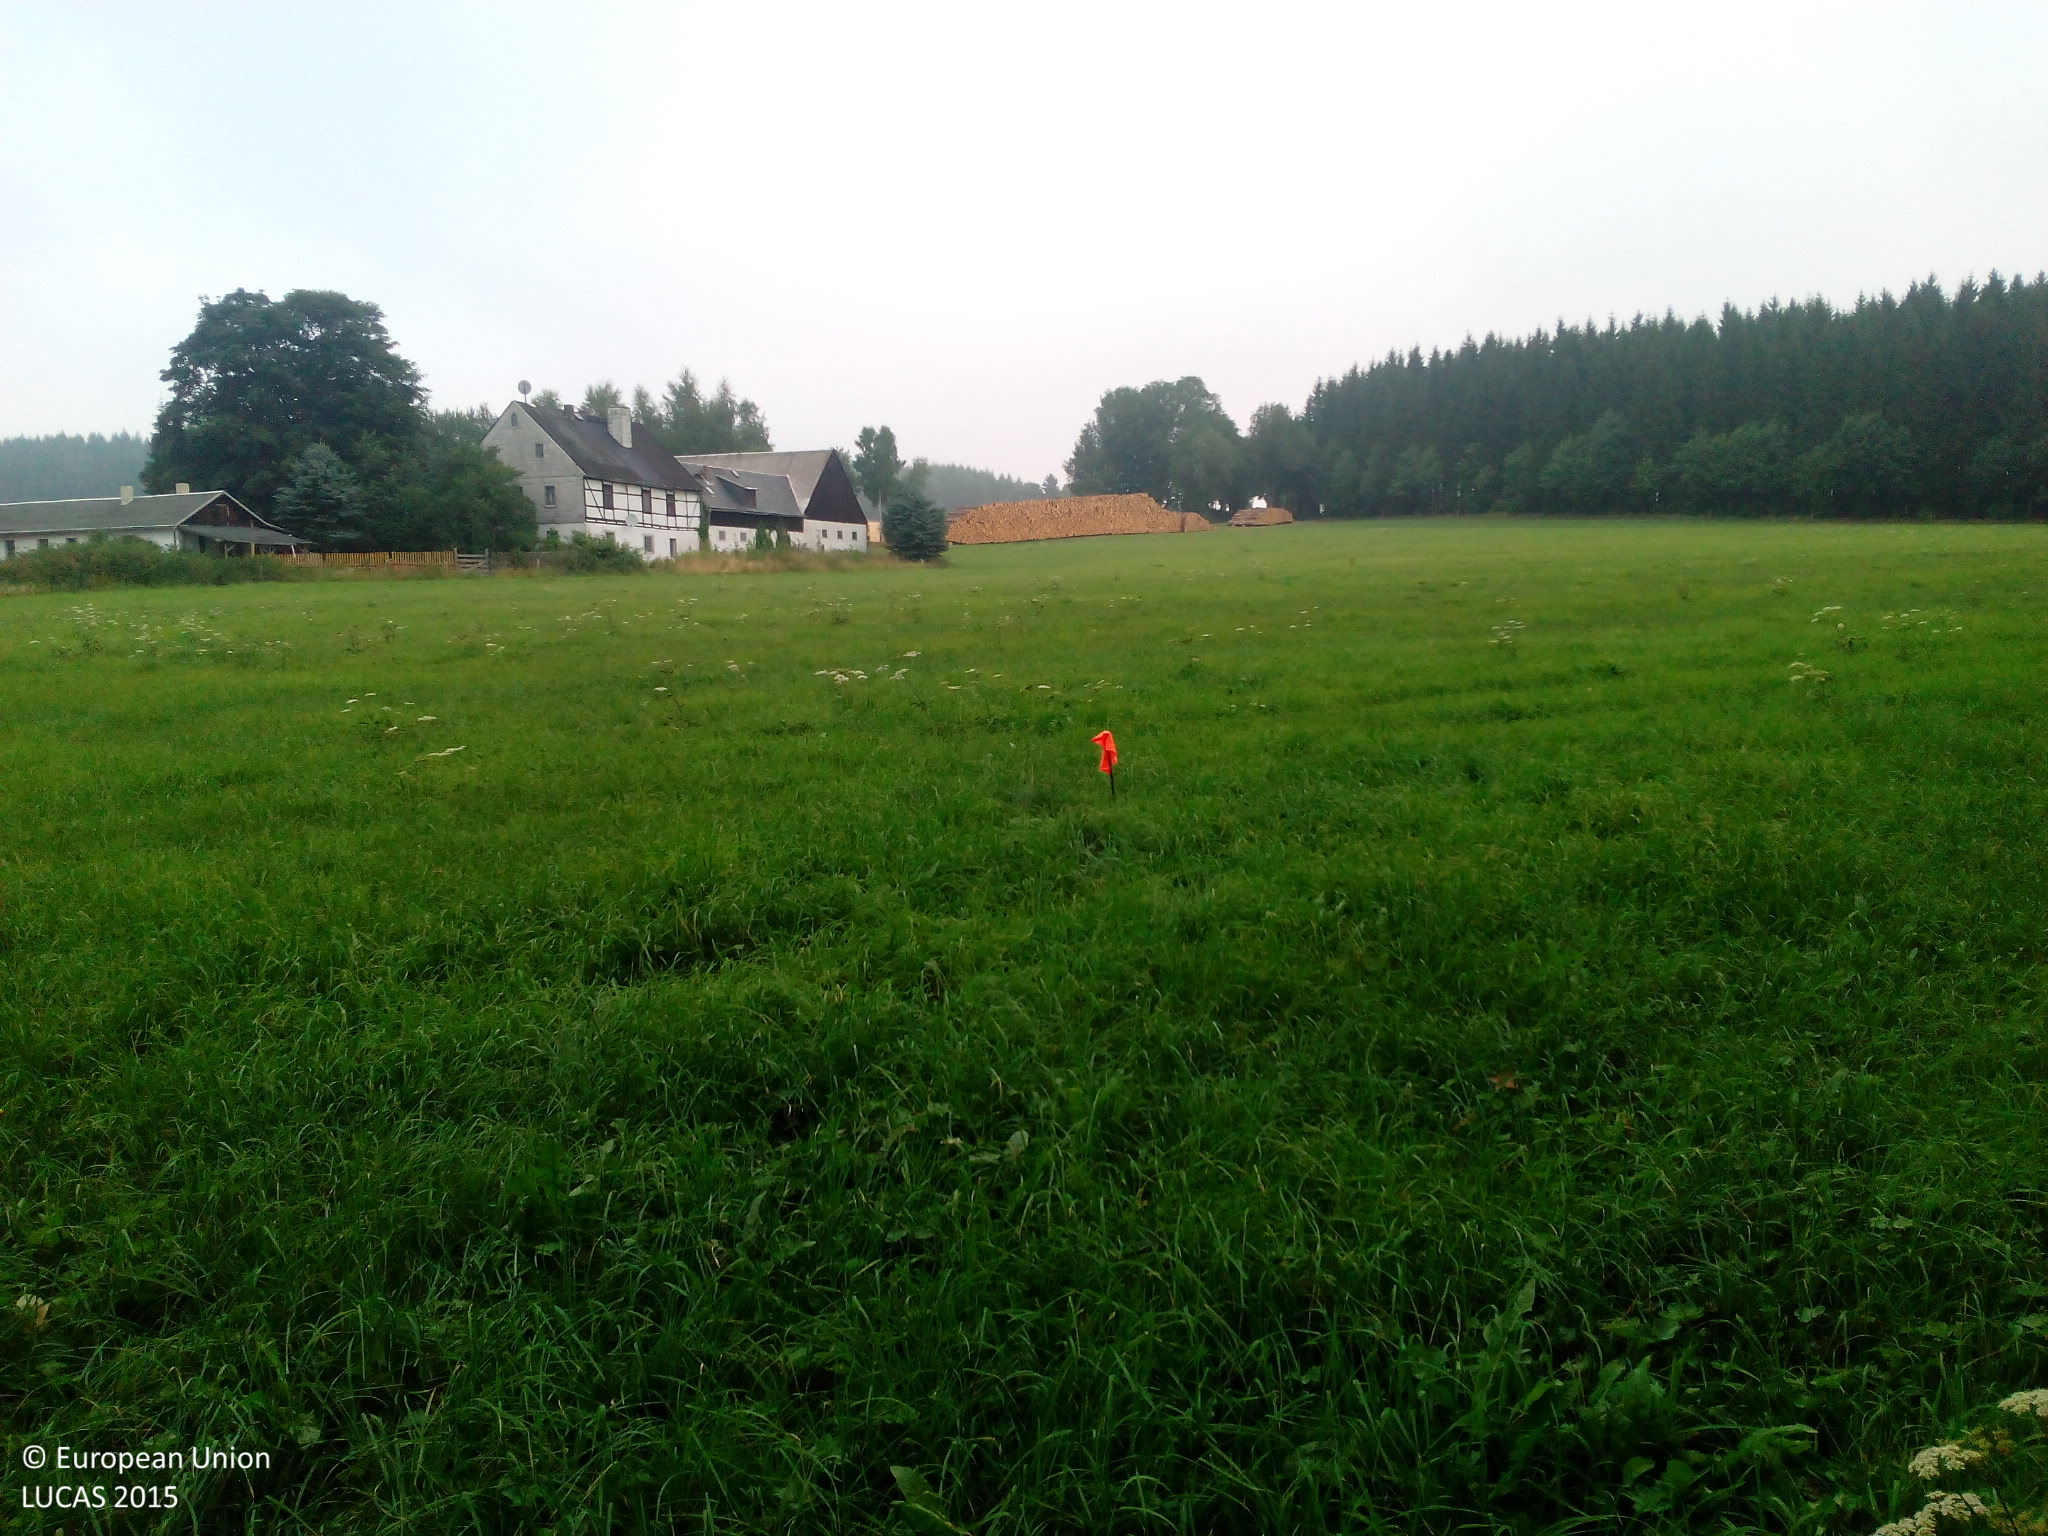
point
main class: Grassland
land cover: Grassland without tree/shrub cover
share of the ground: > 75 %
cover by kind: herbaceous plants 100 %
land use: Agriculture (excluding fallow land and kitchen gardens)
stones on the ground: < 10 %
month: August
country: DE
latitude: 50.6911
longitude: 13.4118
